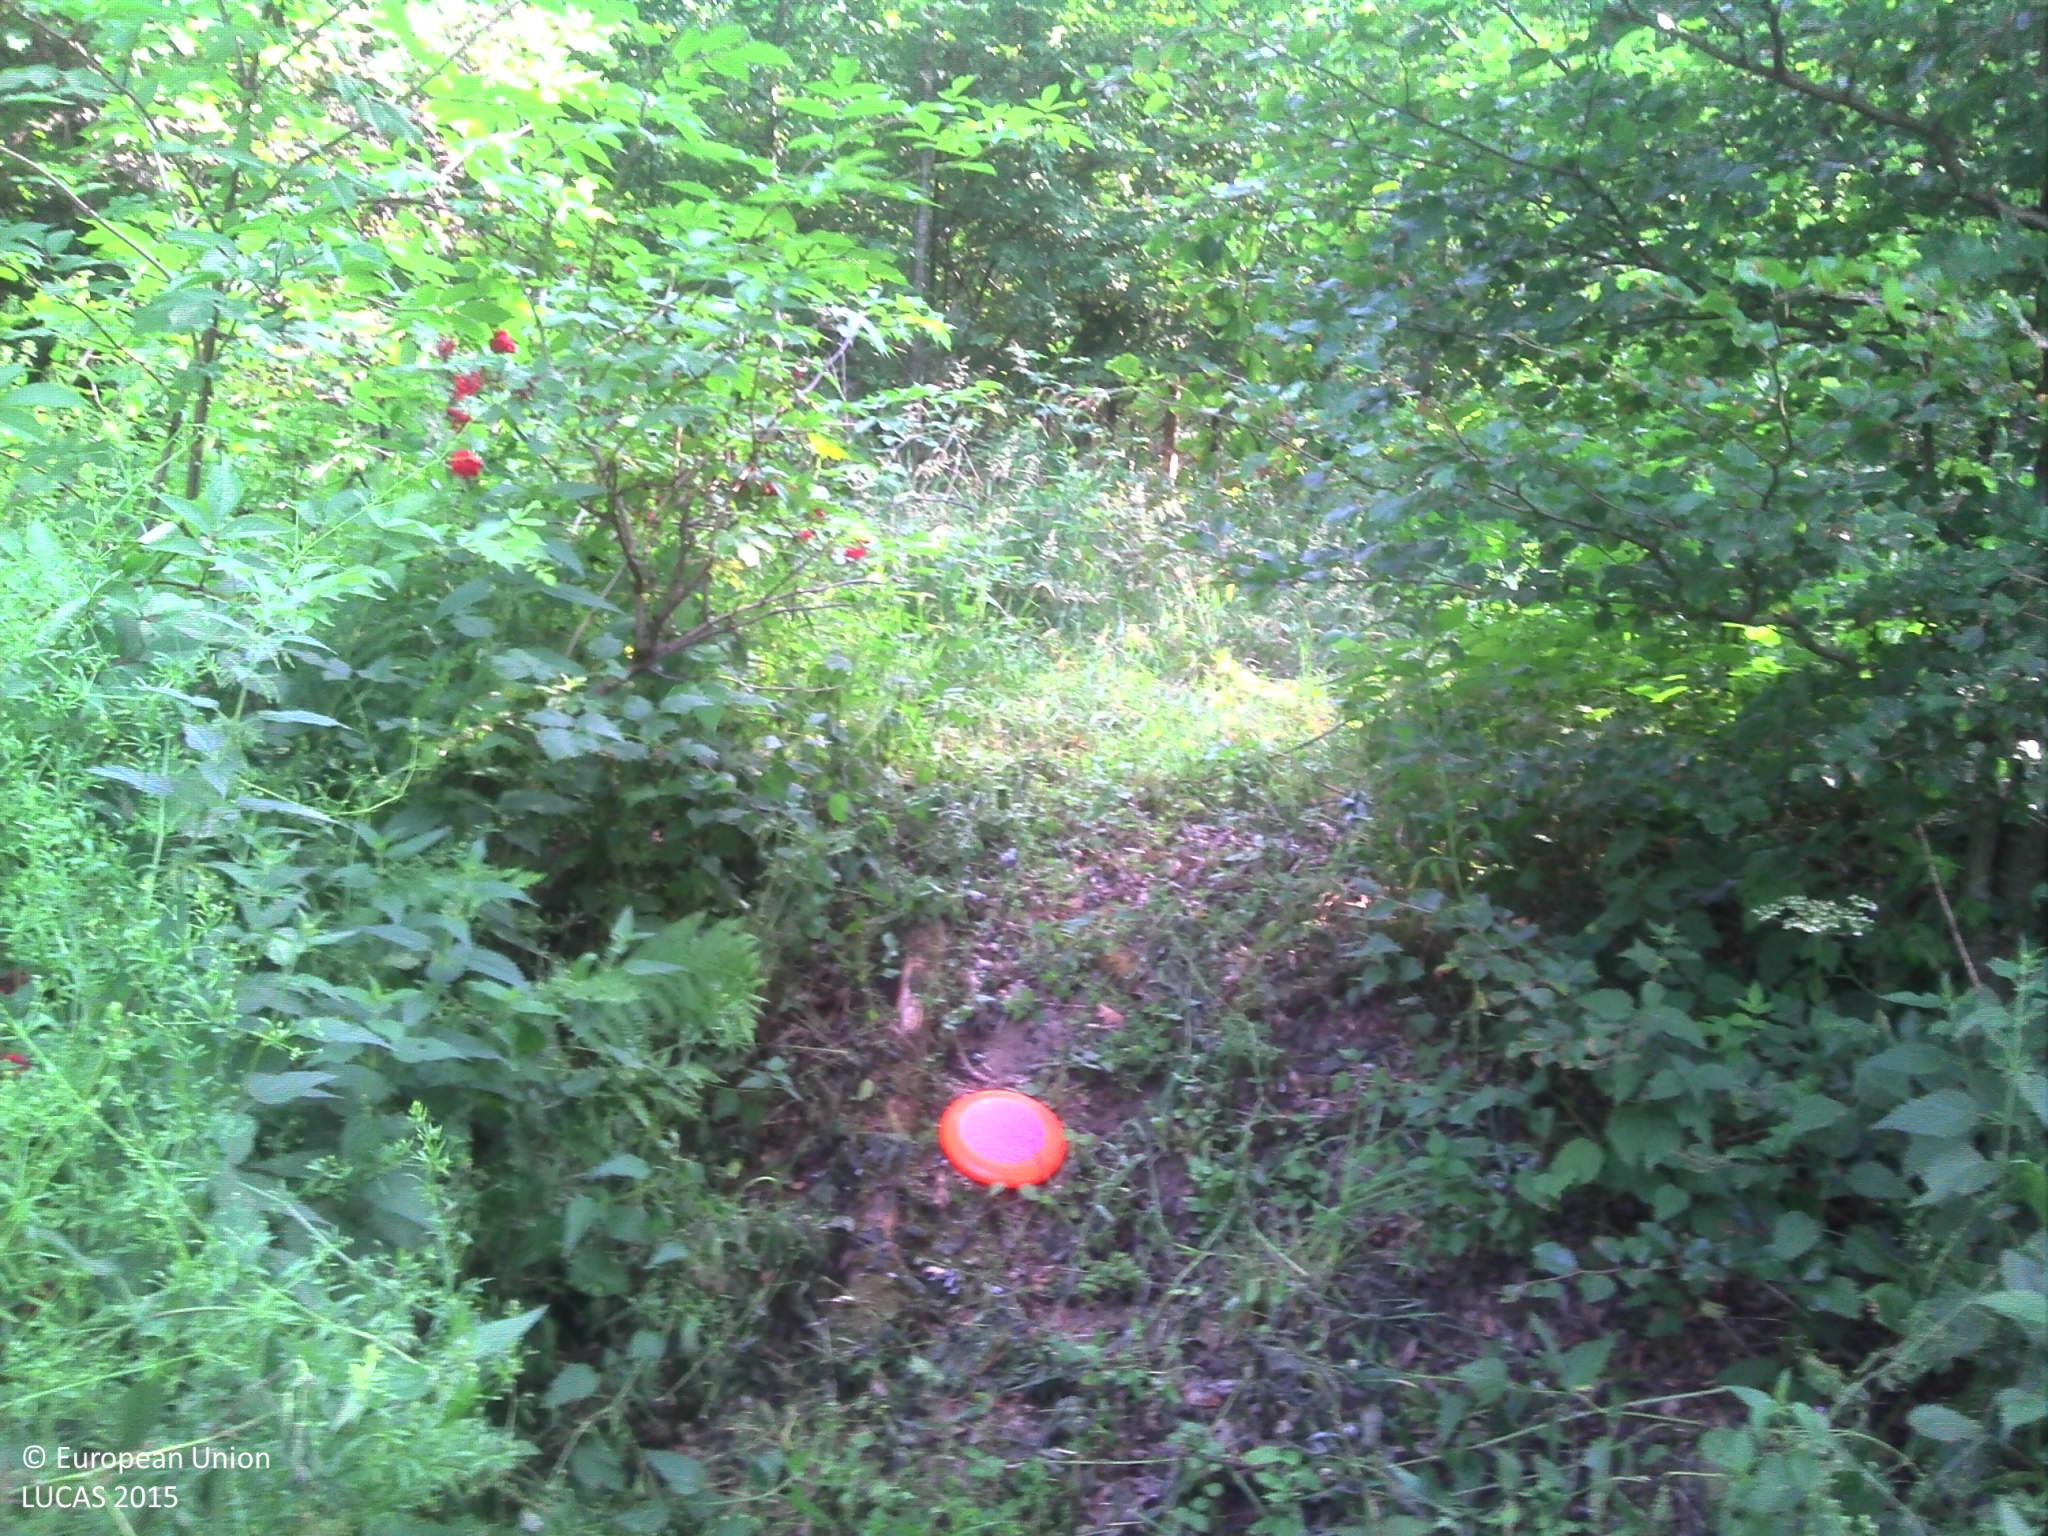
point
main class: Woodland
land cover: Broadleaved woodland
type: acidophilous oak and oak-birch forest
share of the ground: > 75 %
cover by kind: broadleaved forest trees 80 %, herbaceous plants 15 %, shrubs 5 %
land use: Forestry
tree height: > 5 m
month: July
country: BE
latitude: 49.9355
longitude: 5.5540
